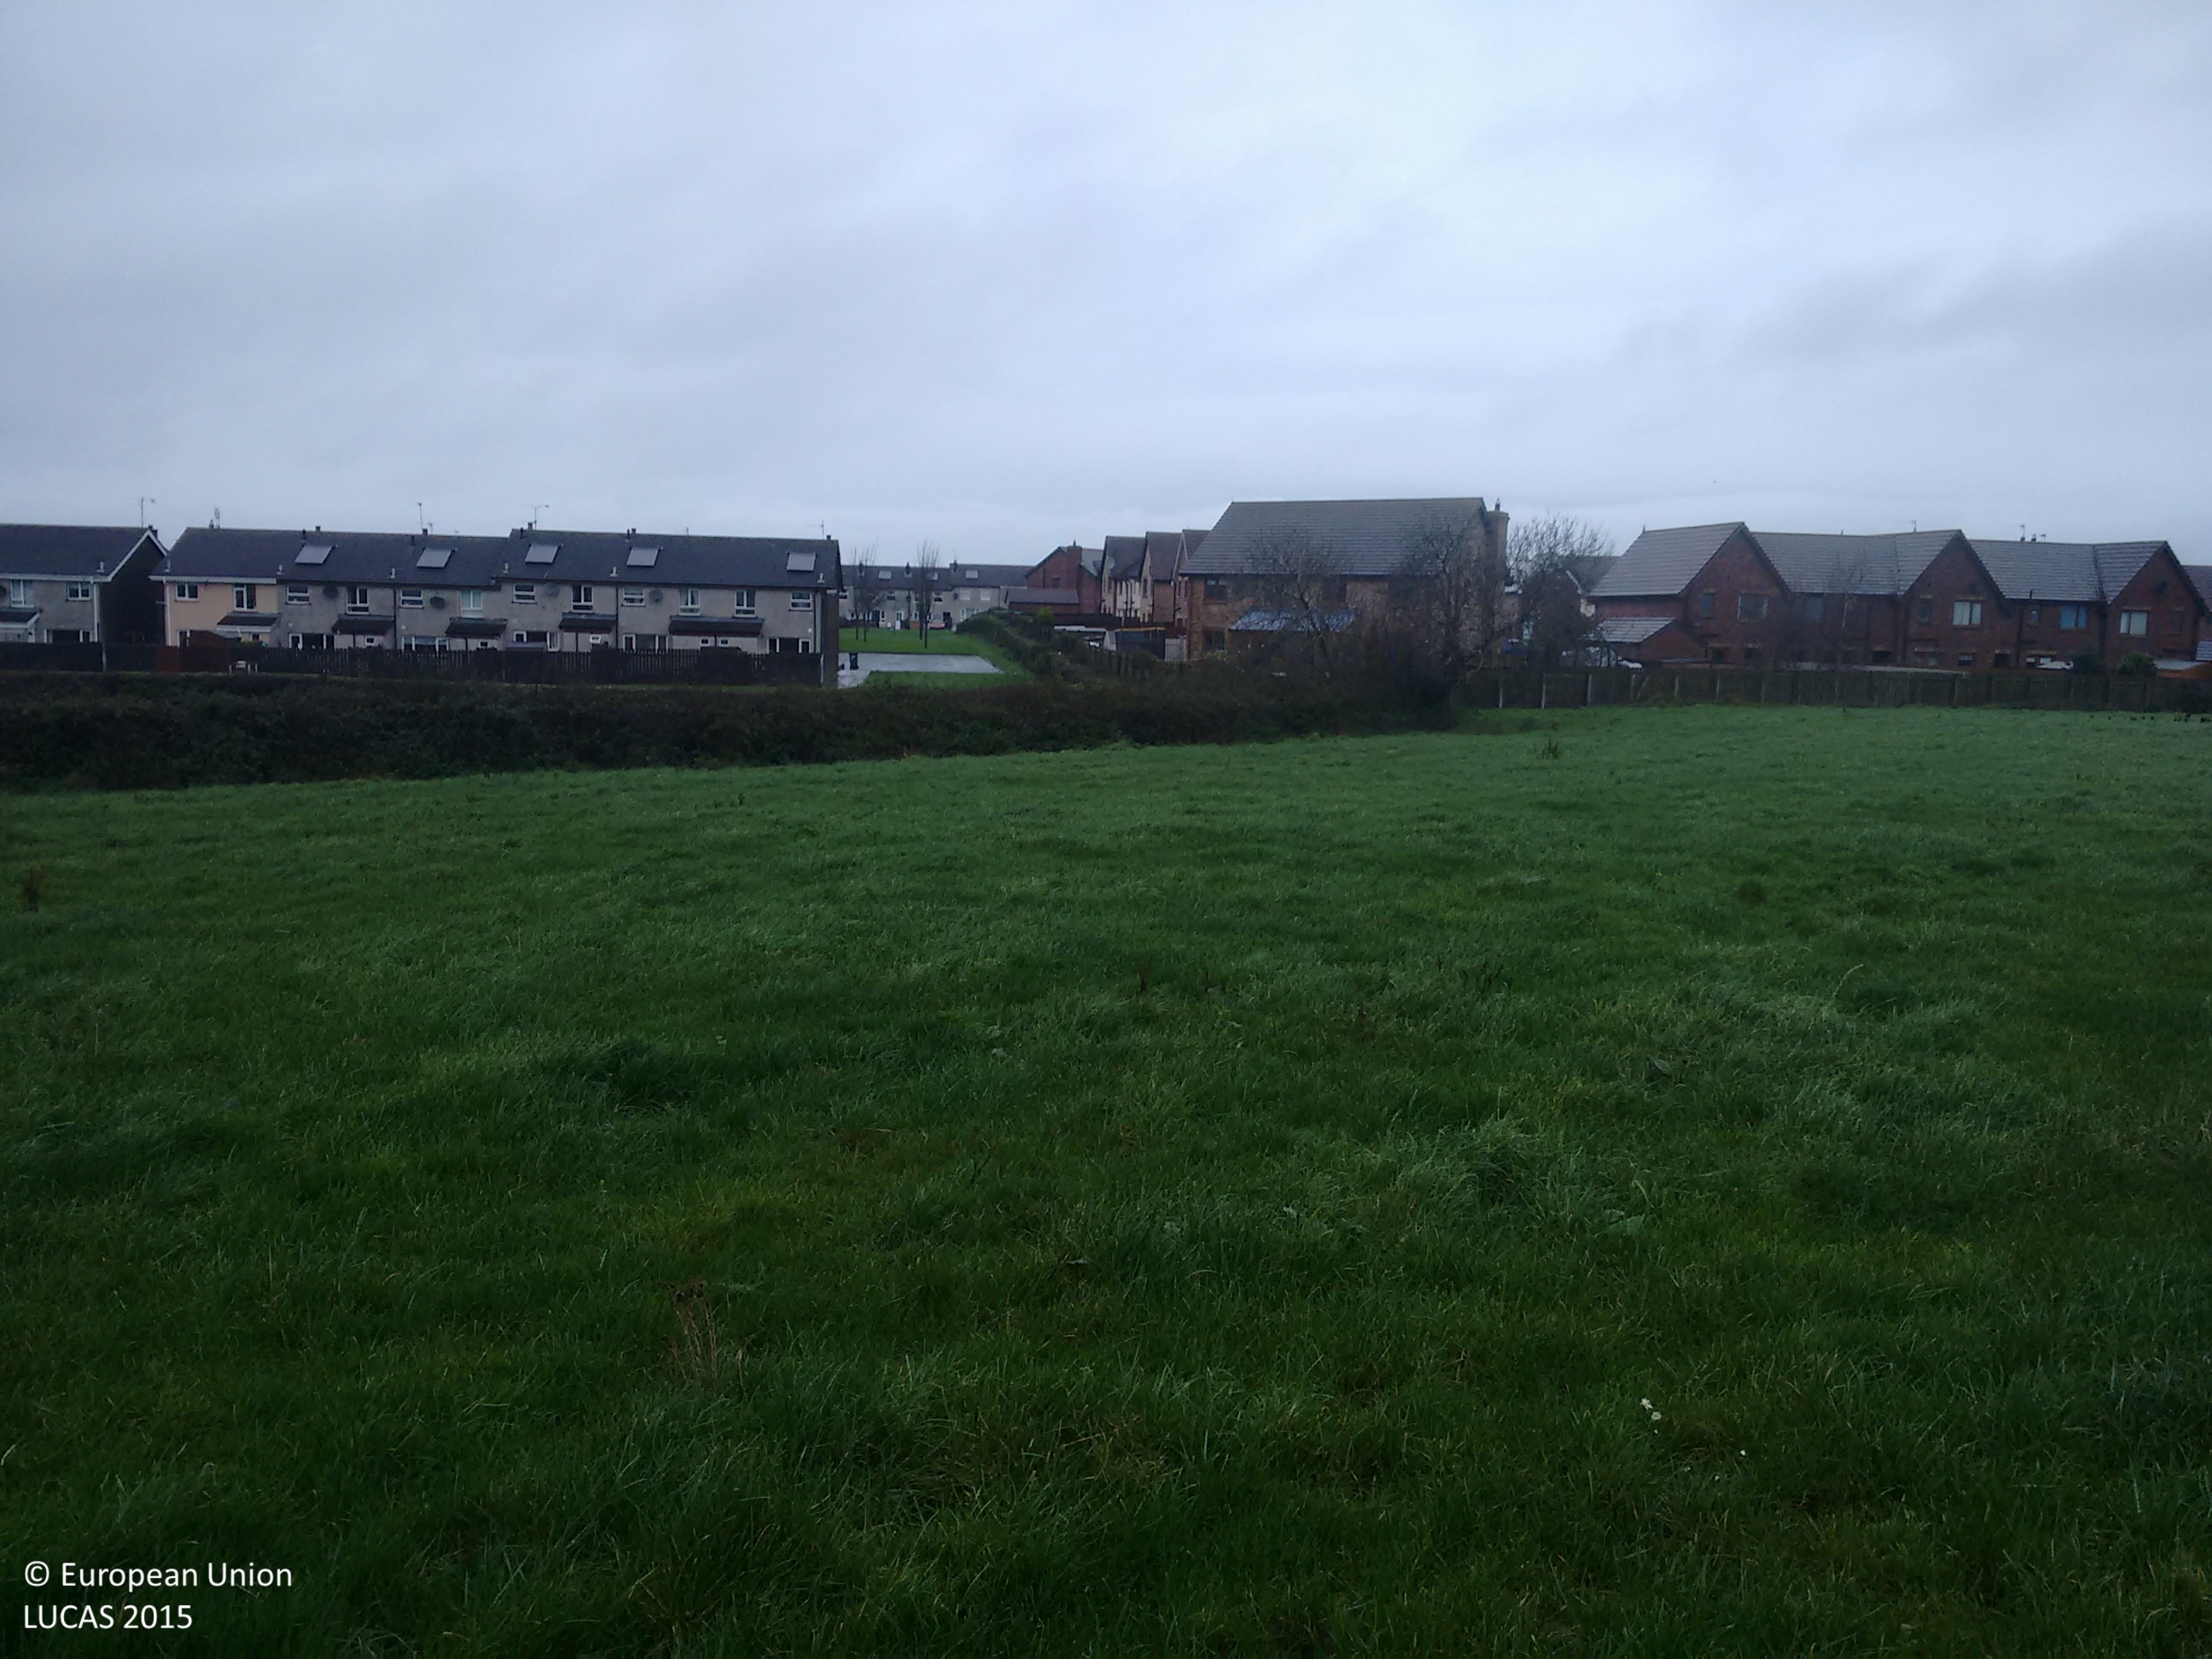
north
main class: Grassland
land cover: Grassland without tree/shrub cover
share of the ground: > 75 %
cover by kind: herbaceous plants 100 %
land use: Agriculture (excluding fallow land and kitchen gardens)
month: November
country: GB
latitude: 54.6290
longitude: -5.6682
